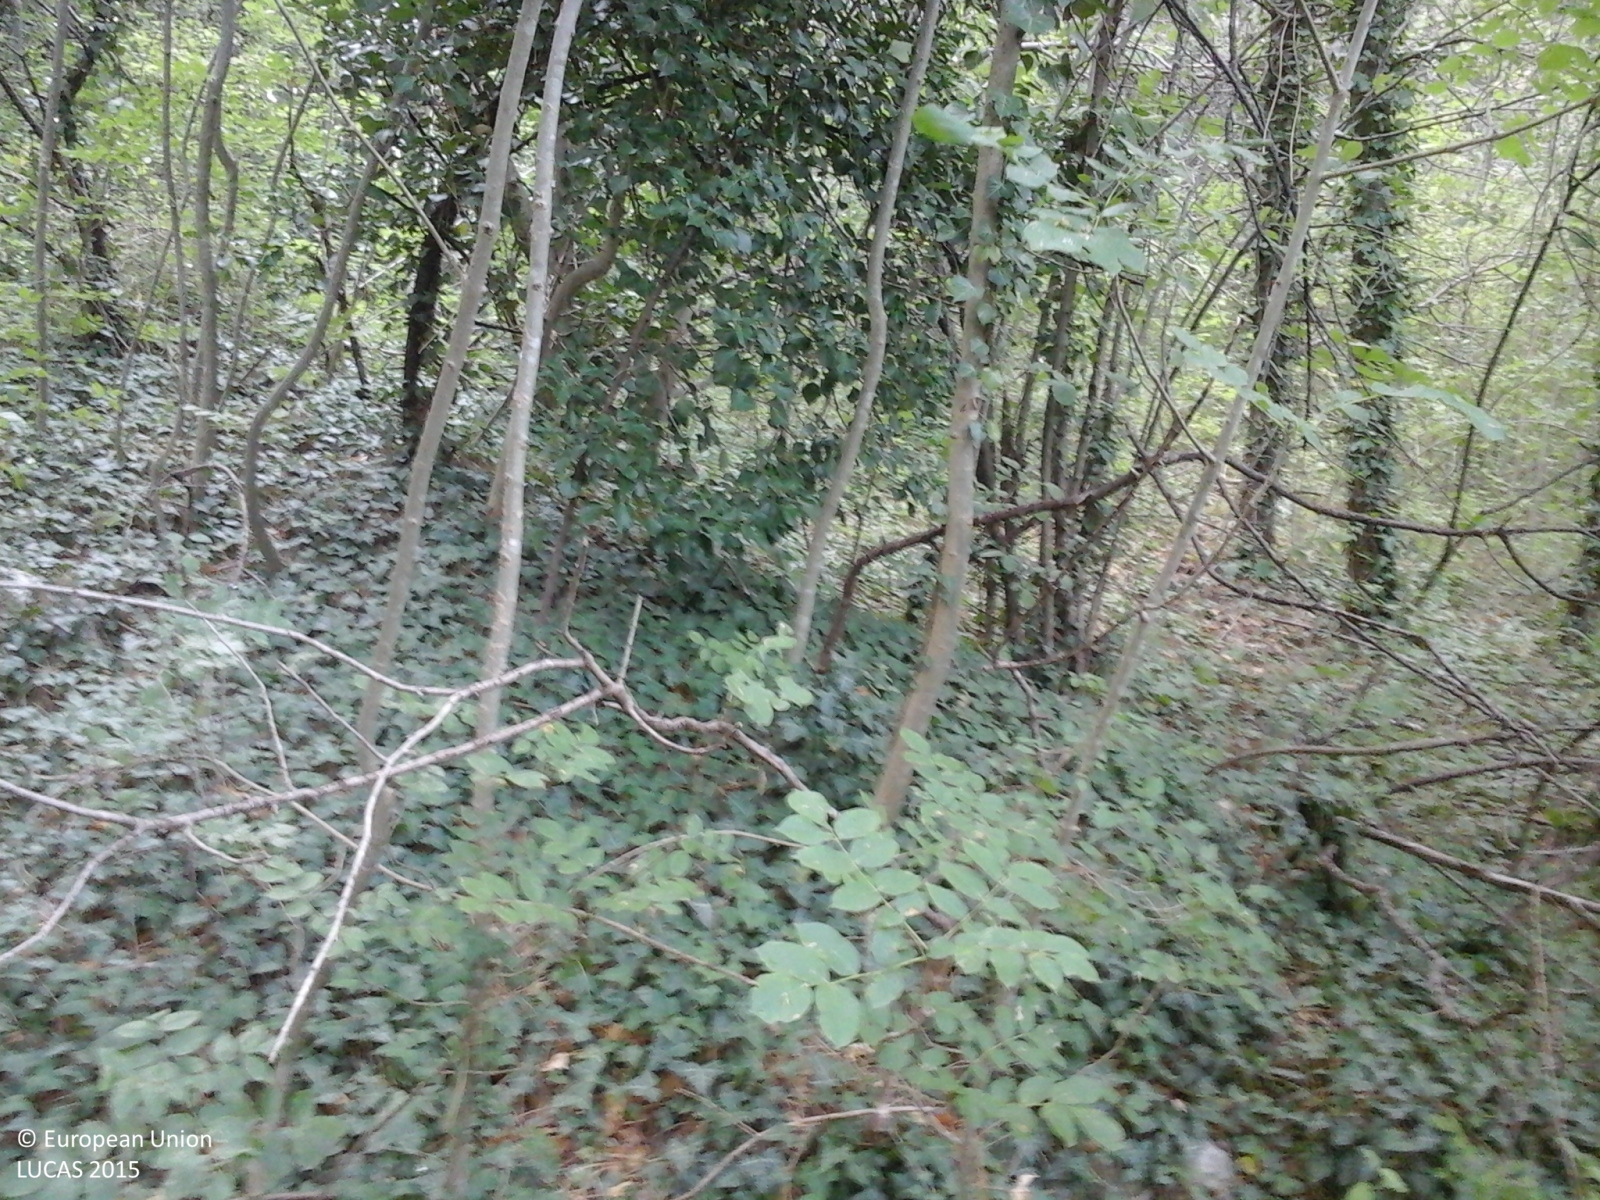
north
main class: Woodland
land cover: Broadleaved woodland
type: thermophilous deciduous forest
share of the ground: > 75 %
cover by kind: broadleaved forest trees 80 %, coniferous forest trees 20 %
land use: Forestry
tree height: > 5 m
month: July
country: IT
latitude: 45.4977
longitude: 11.1881
